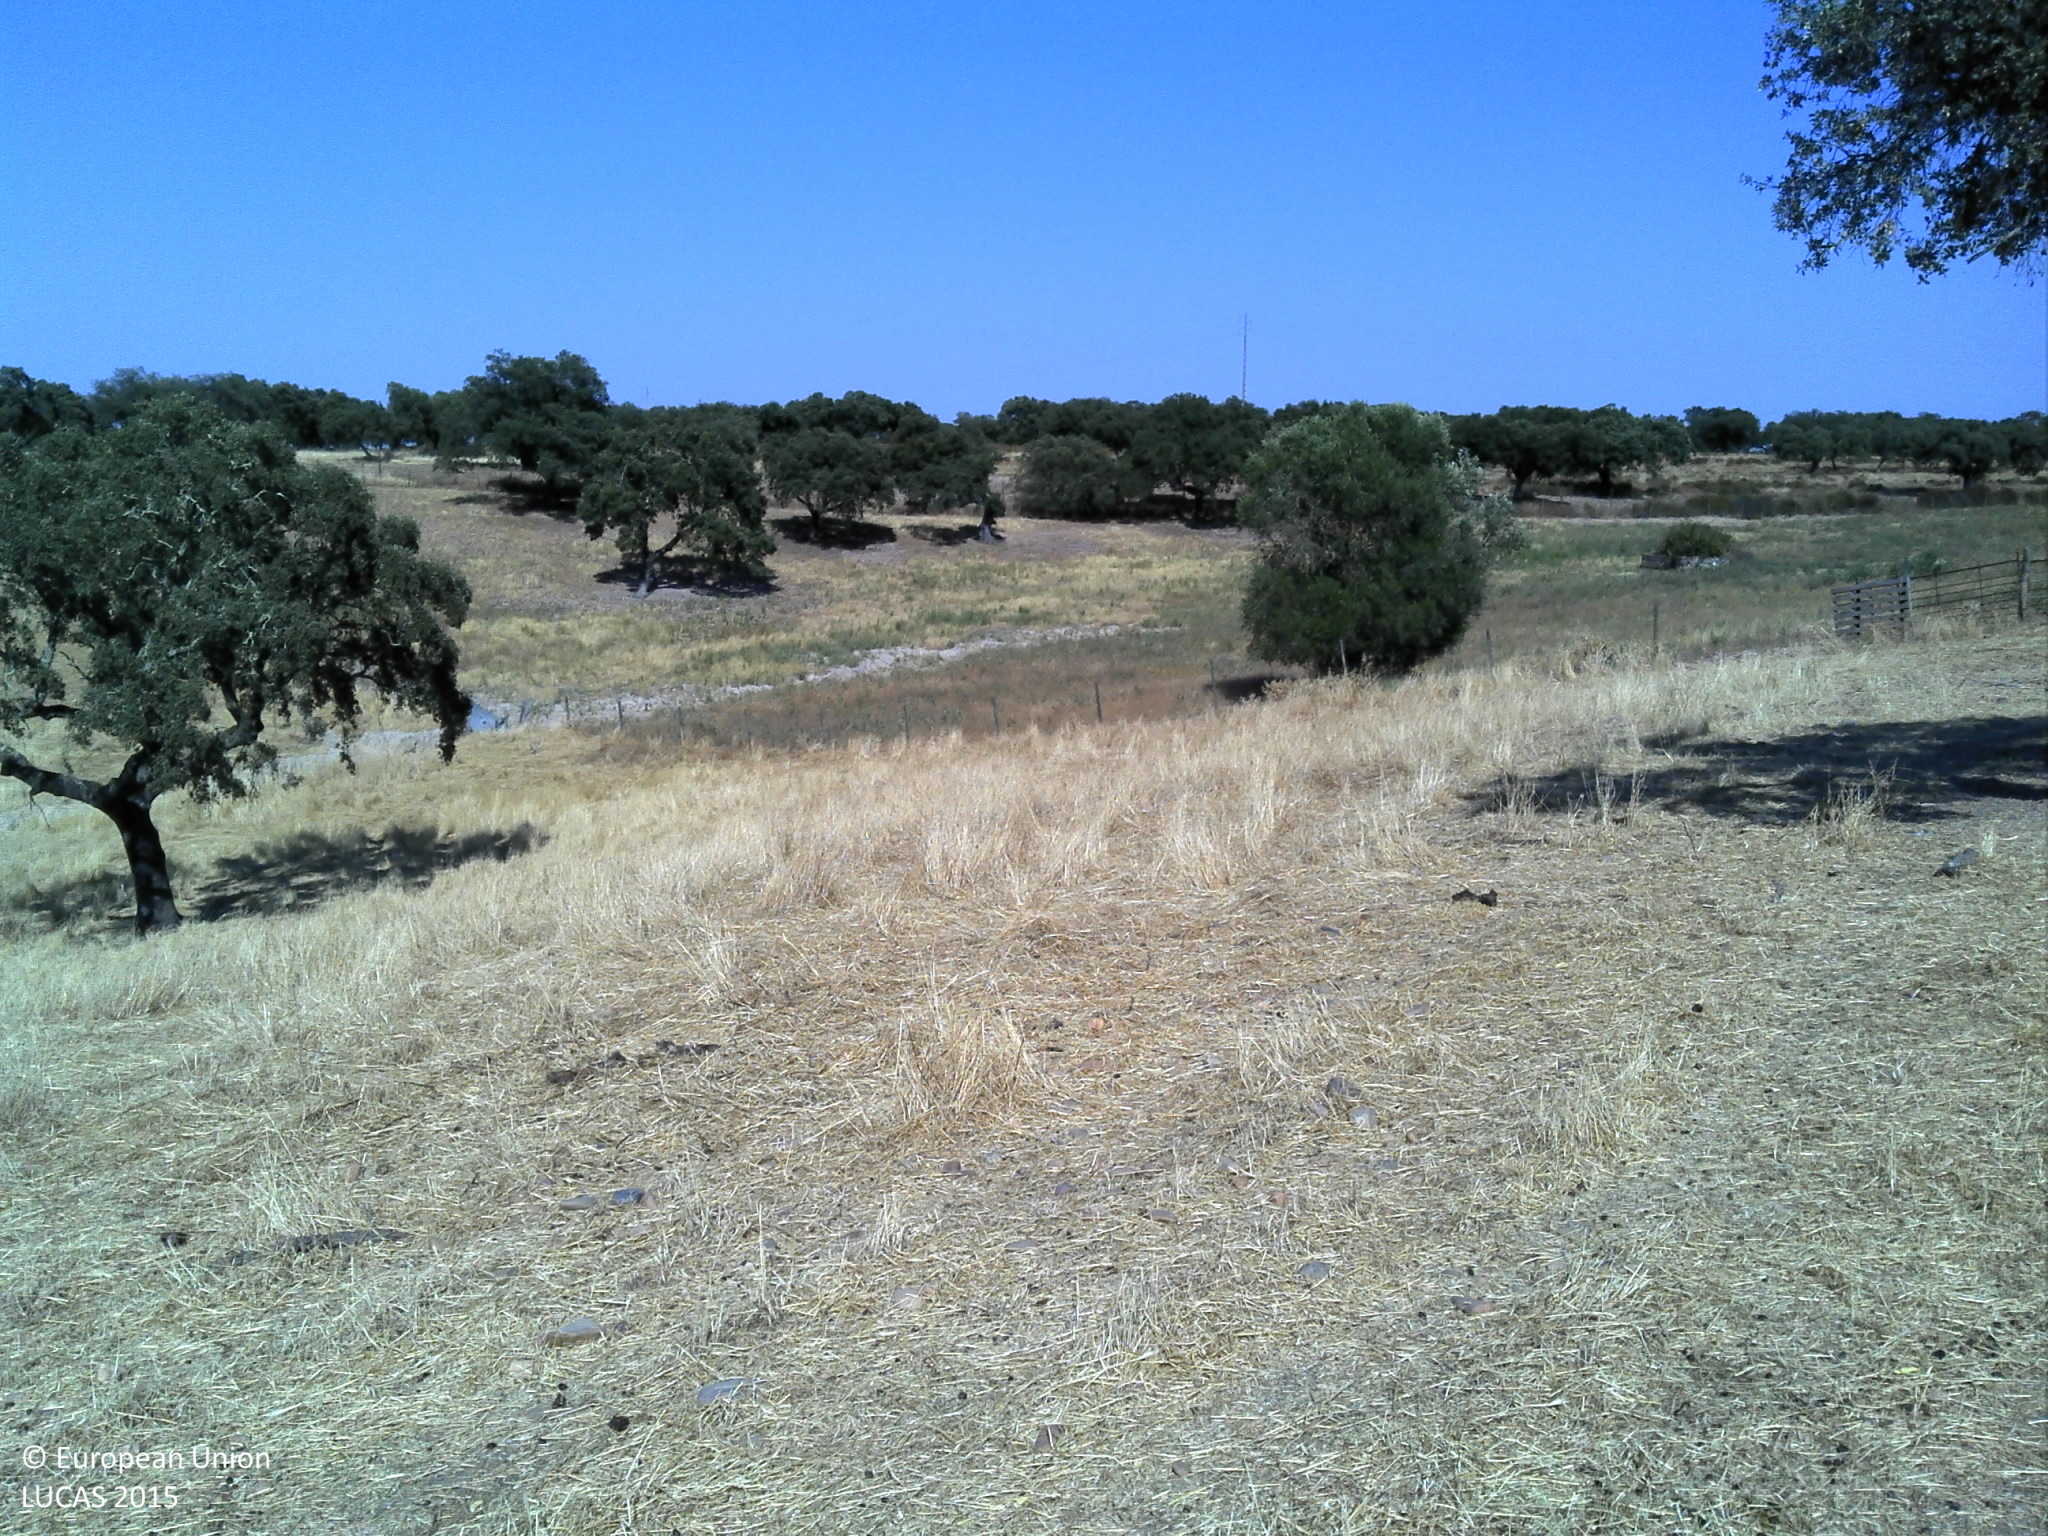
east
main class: Grassland
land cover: Grassland with sparse tree/shrub cover
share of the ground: 25 - 50 %
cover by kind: herbaceous plants 50 %, unconsolidated bare surface 45 %, broadleaved forest trees 5 %
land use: Agriculture (excluding fallow land and kitchen gardens)
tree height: < 5 m
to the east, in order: Grassland with sparse tree/shrub cover; Fences; Grassland without tree/shrub cover; Rivers and streams; Grassland without tree/shrub cover; Broadleaved woodland; Fences; Grass margins; Fences; Broadleaved woodland; Grassland without tree/shrub cover; Shrubland without tree cover; Broadleaved woodland
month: June
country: PT
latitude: 38.0999
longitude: -7.6426
